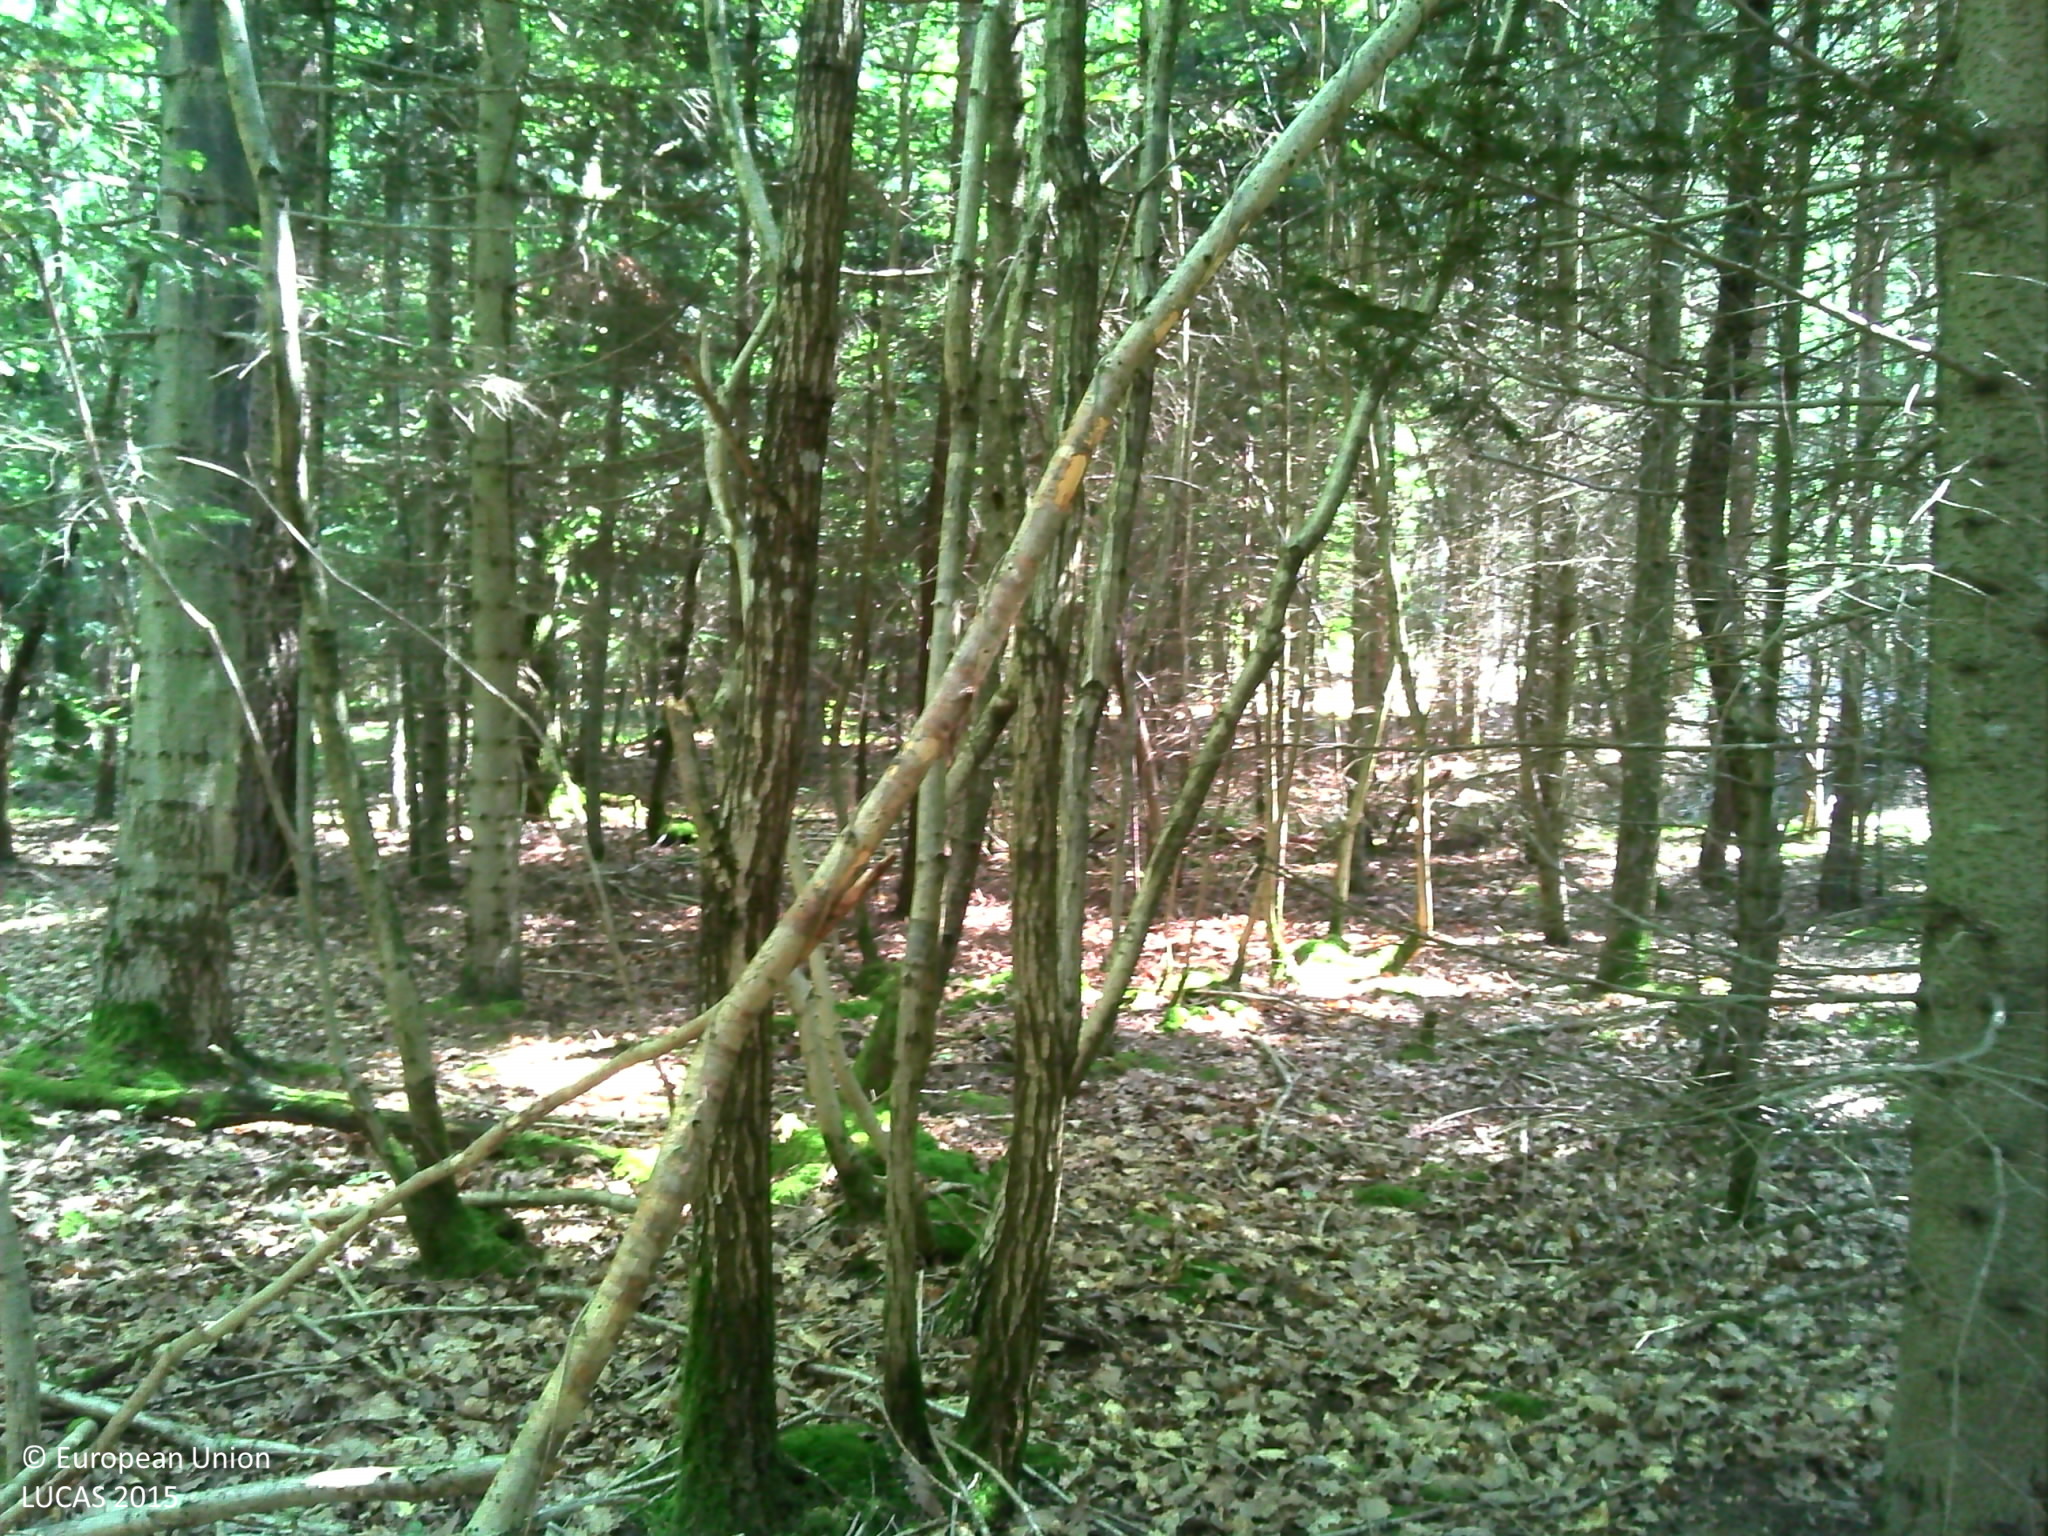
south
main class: Woodland
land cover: Spruce dominated mixed woodland
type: acidophilous oak and oak-birch forest
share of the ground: > 75 %
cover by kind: broadleaved forest trees 70 %, coniferous forest trees 25 %, lichens and mosses 5 %
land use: Forestry
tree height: > 5 m
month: June
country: FR
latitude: 46.1429
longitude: 3.0465
